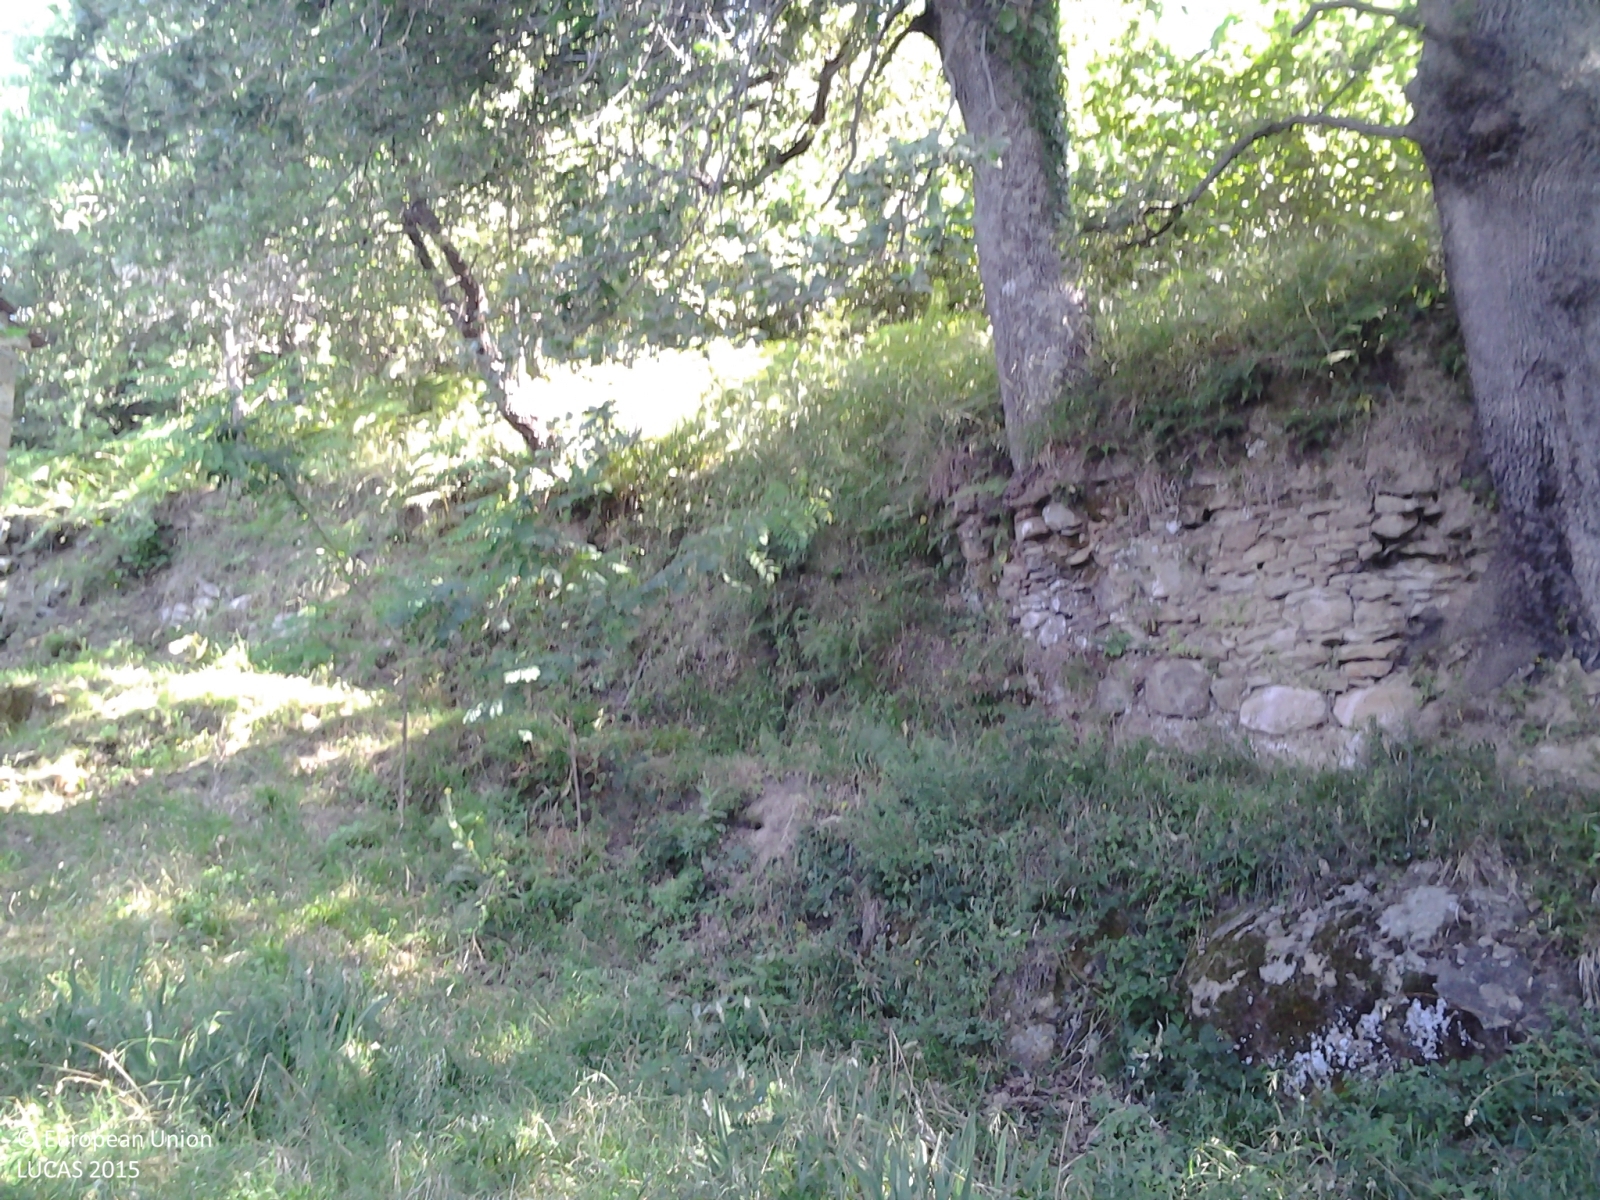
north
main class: Cropland
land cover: Nuts trees
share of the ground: > 75 %
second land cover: Spontaneously vegetated surfaces
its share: > 75 %
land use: Agriculture (excluding fallow land and kitchen gardens)
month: July
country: IT
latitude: 38.0936
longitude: 14.9049
